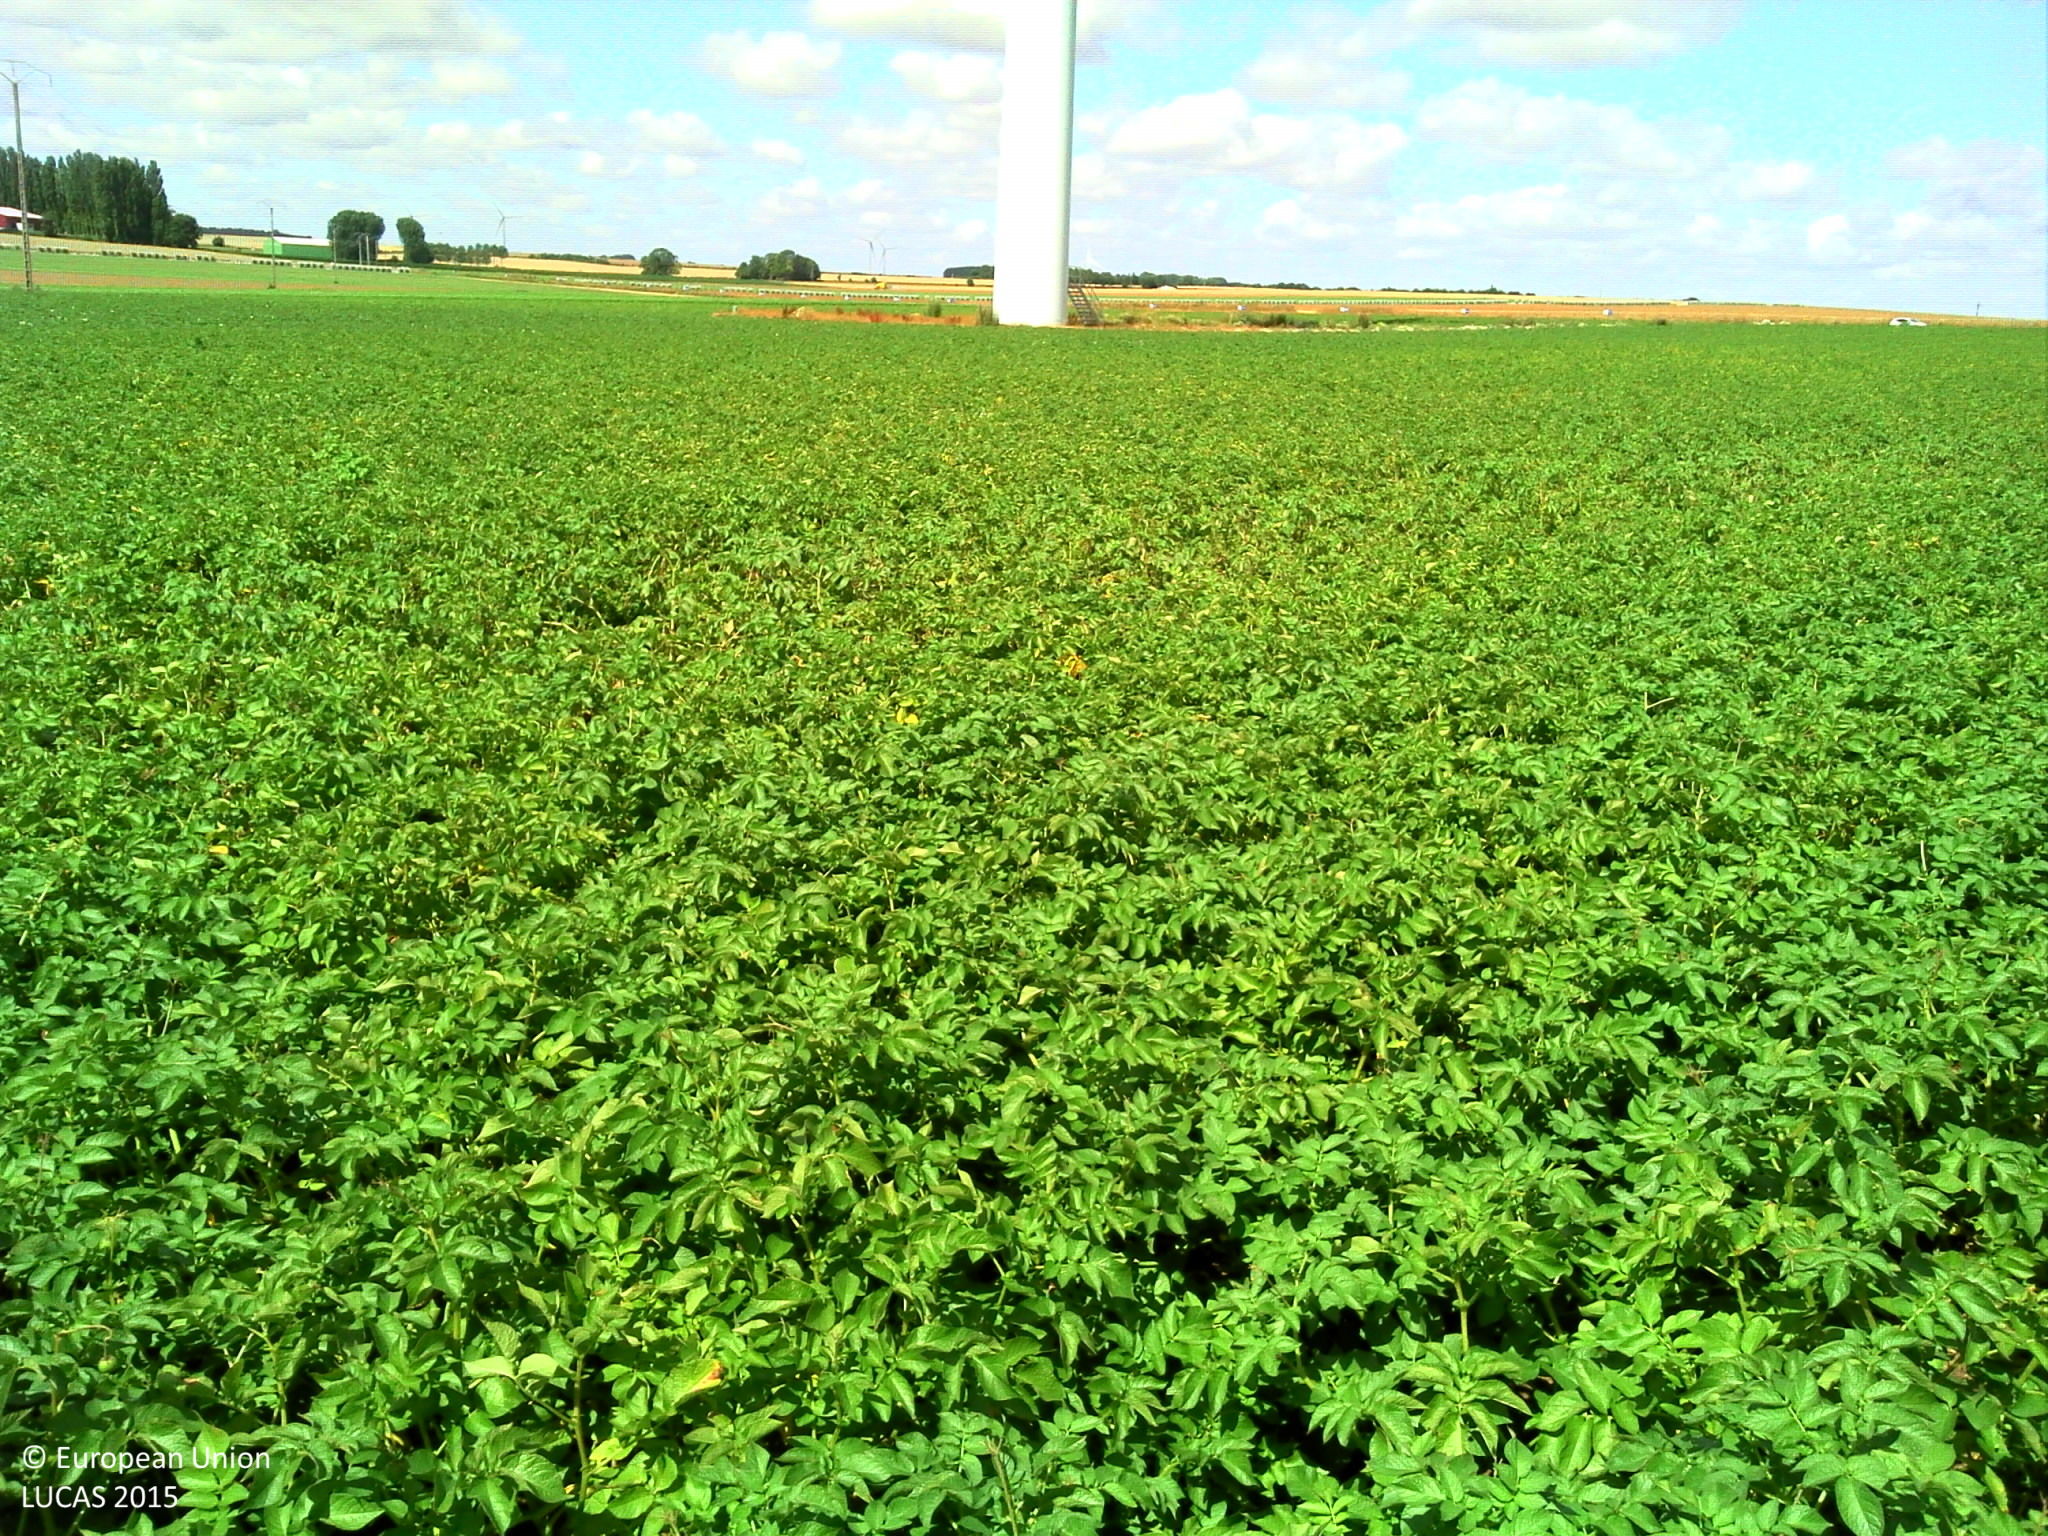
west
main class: Cropland
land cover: Potatoes
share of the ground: > 75 %
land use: Agriculture (excluding fallow land and kitchen gardens)
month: July
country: FR
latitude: 50.1557
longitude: 2.8090
